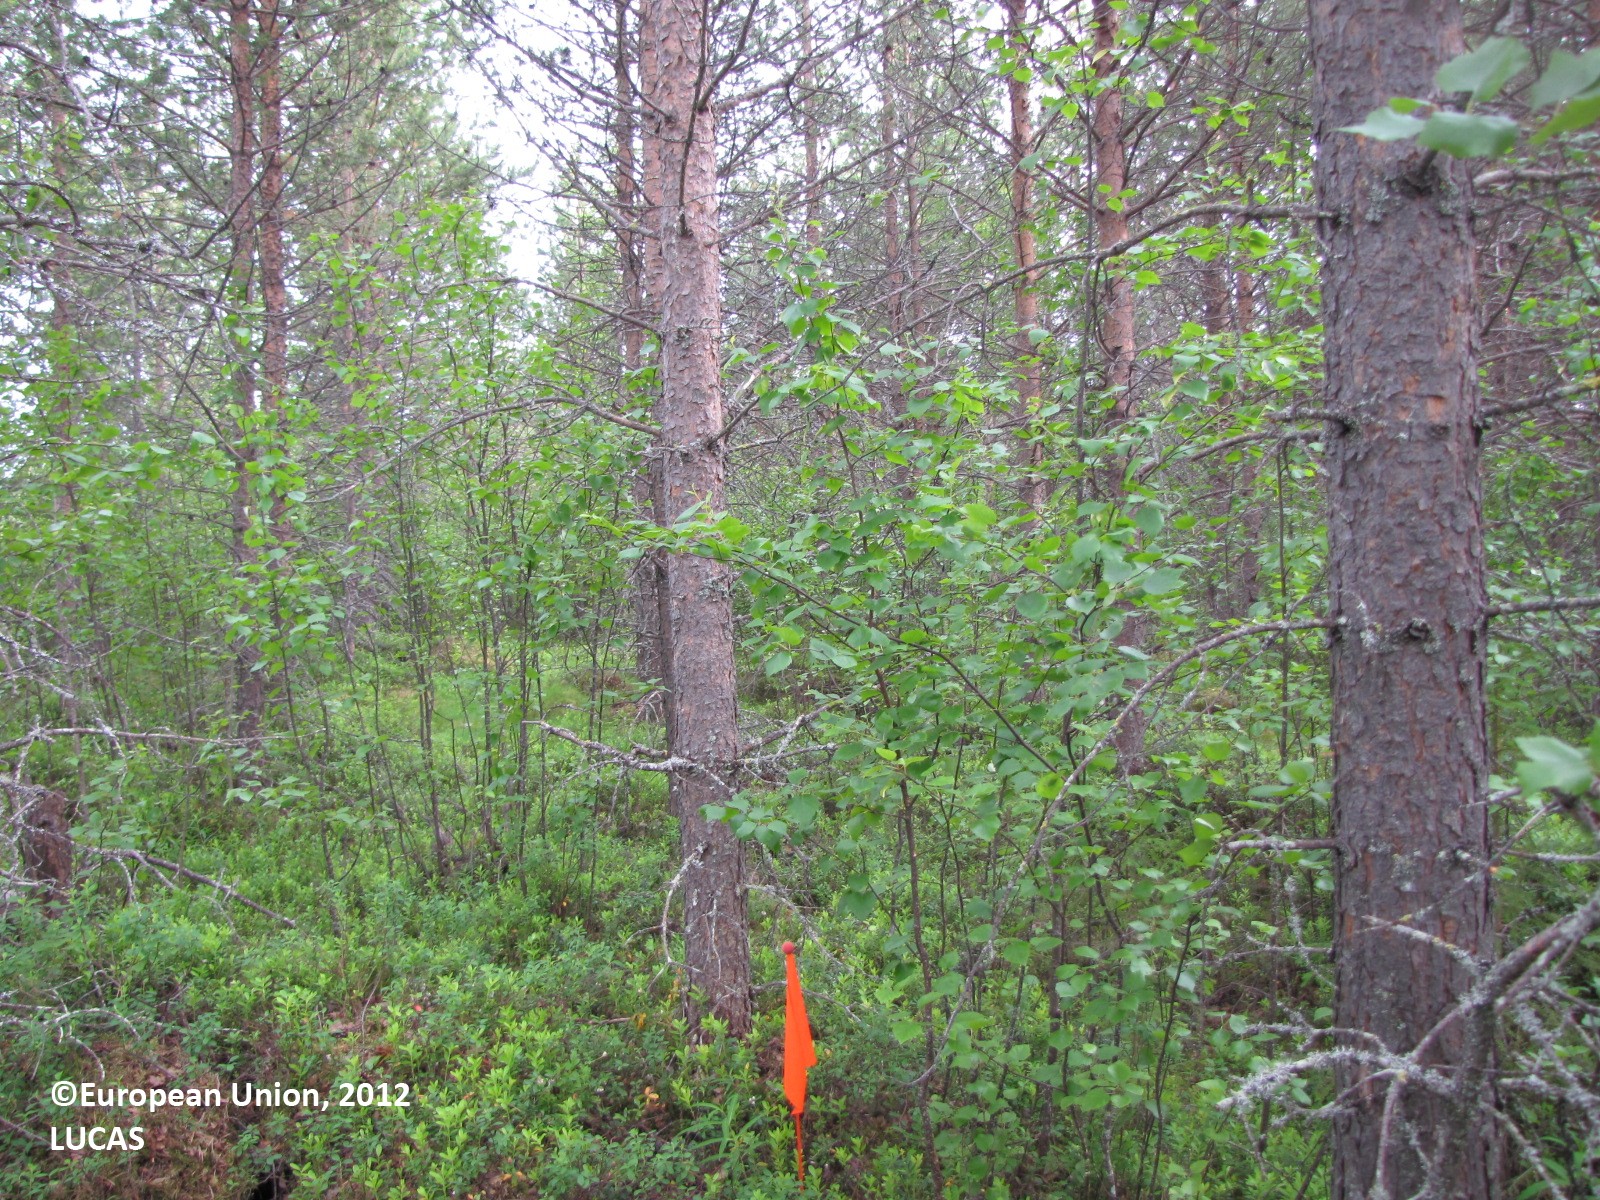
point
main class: Woodland
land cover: Pine dominated mixed woodland
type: boreal forest
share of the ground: 50 - 75 %
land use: Forestry
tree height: > 5 m
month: July
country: FI
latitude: 66.3900
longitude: 25.0705
